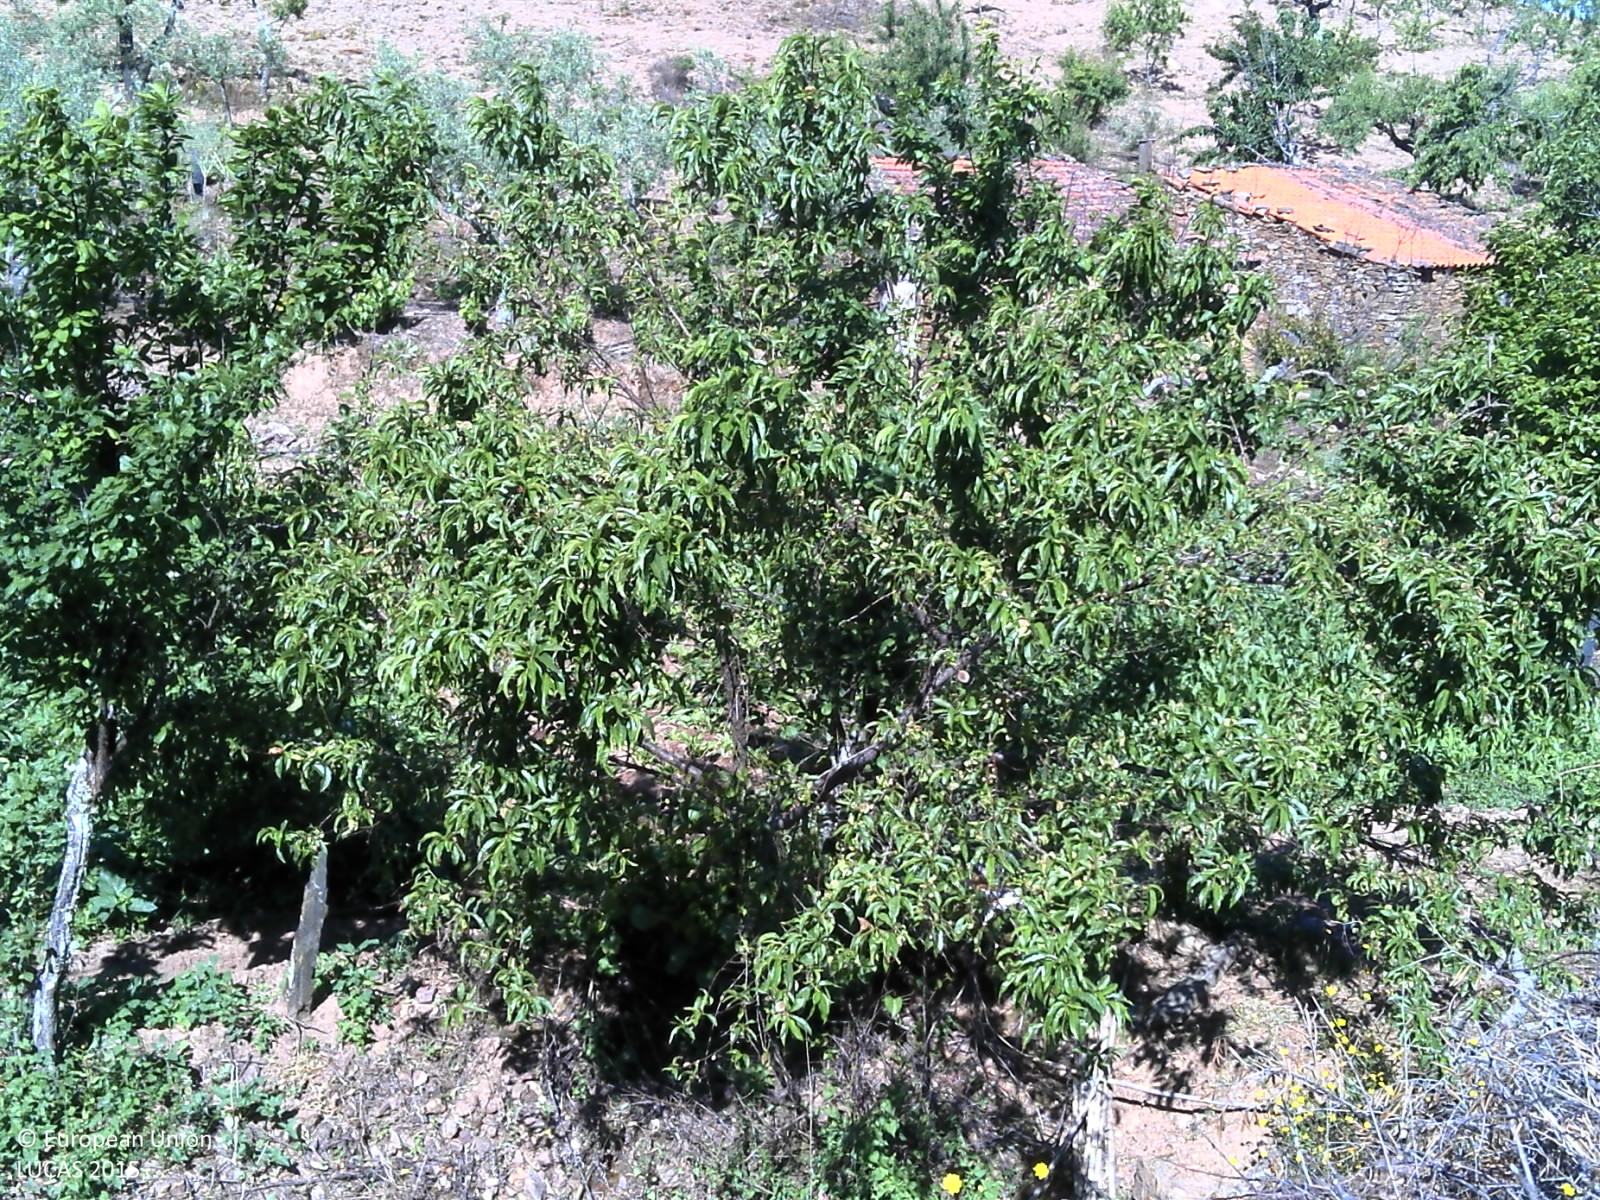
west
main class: Cropland
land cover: Olive groves
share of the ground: 25 - 50 %
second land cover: Vineyards
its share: < 10 %
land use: Agriculture (excluding fallow land and kitchen gardens)
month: May
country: PT
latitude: 41.1057
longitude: -6.9322
